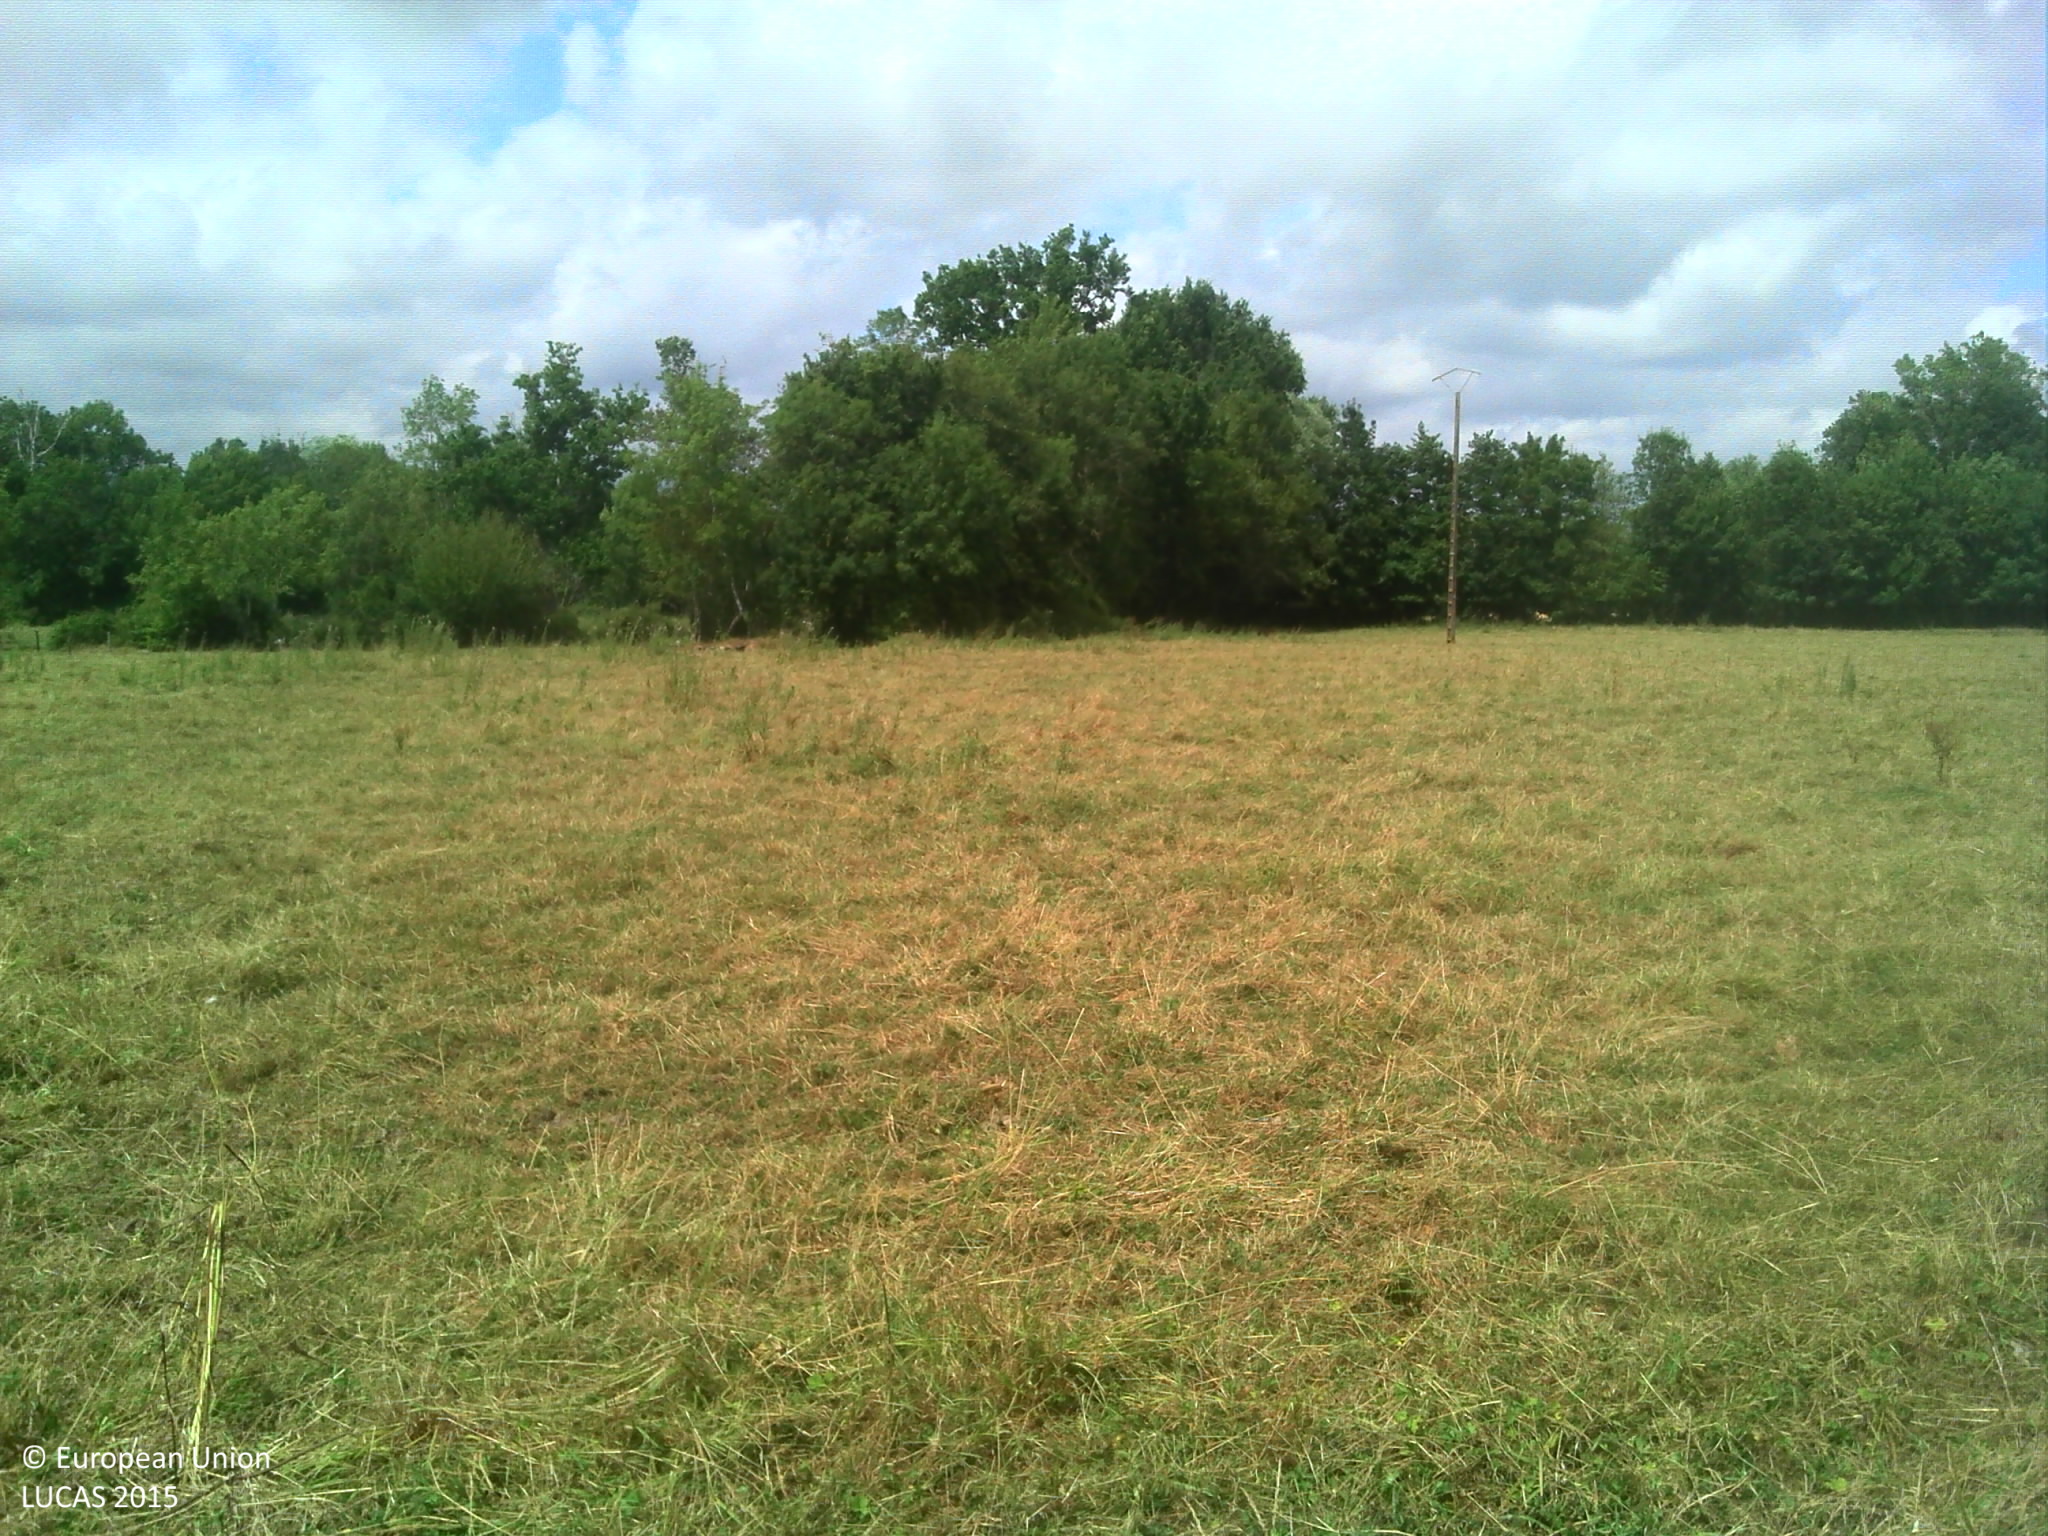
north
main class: Grassland
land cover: Grassland without tree/shrub cover
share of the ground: > 75 %
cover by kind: herbaceous plants 100 %
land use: Agriculture (excluding fallow land and kitchen gardens)
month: July
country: FR
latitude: 46.4923
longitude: -1.3313
